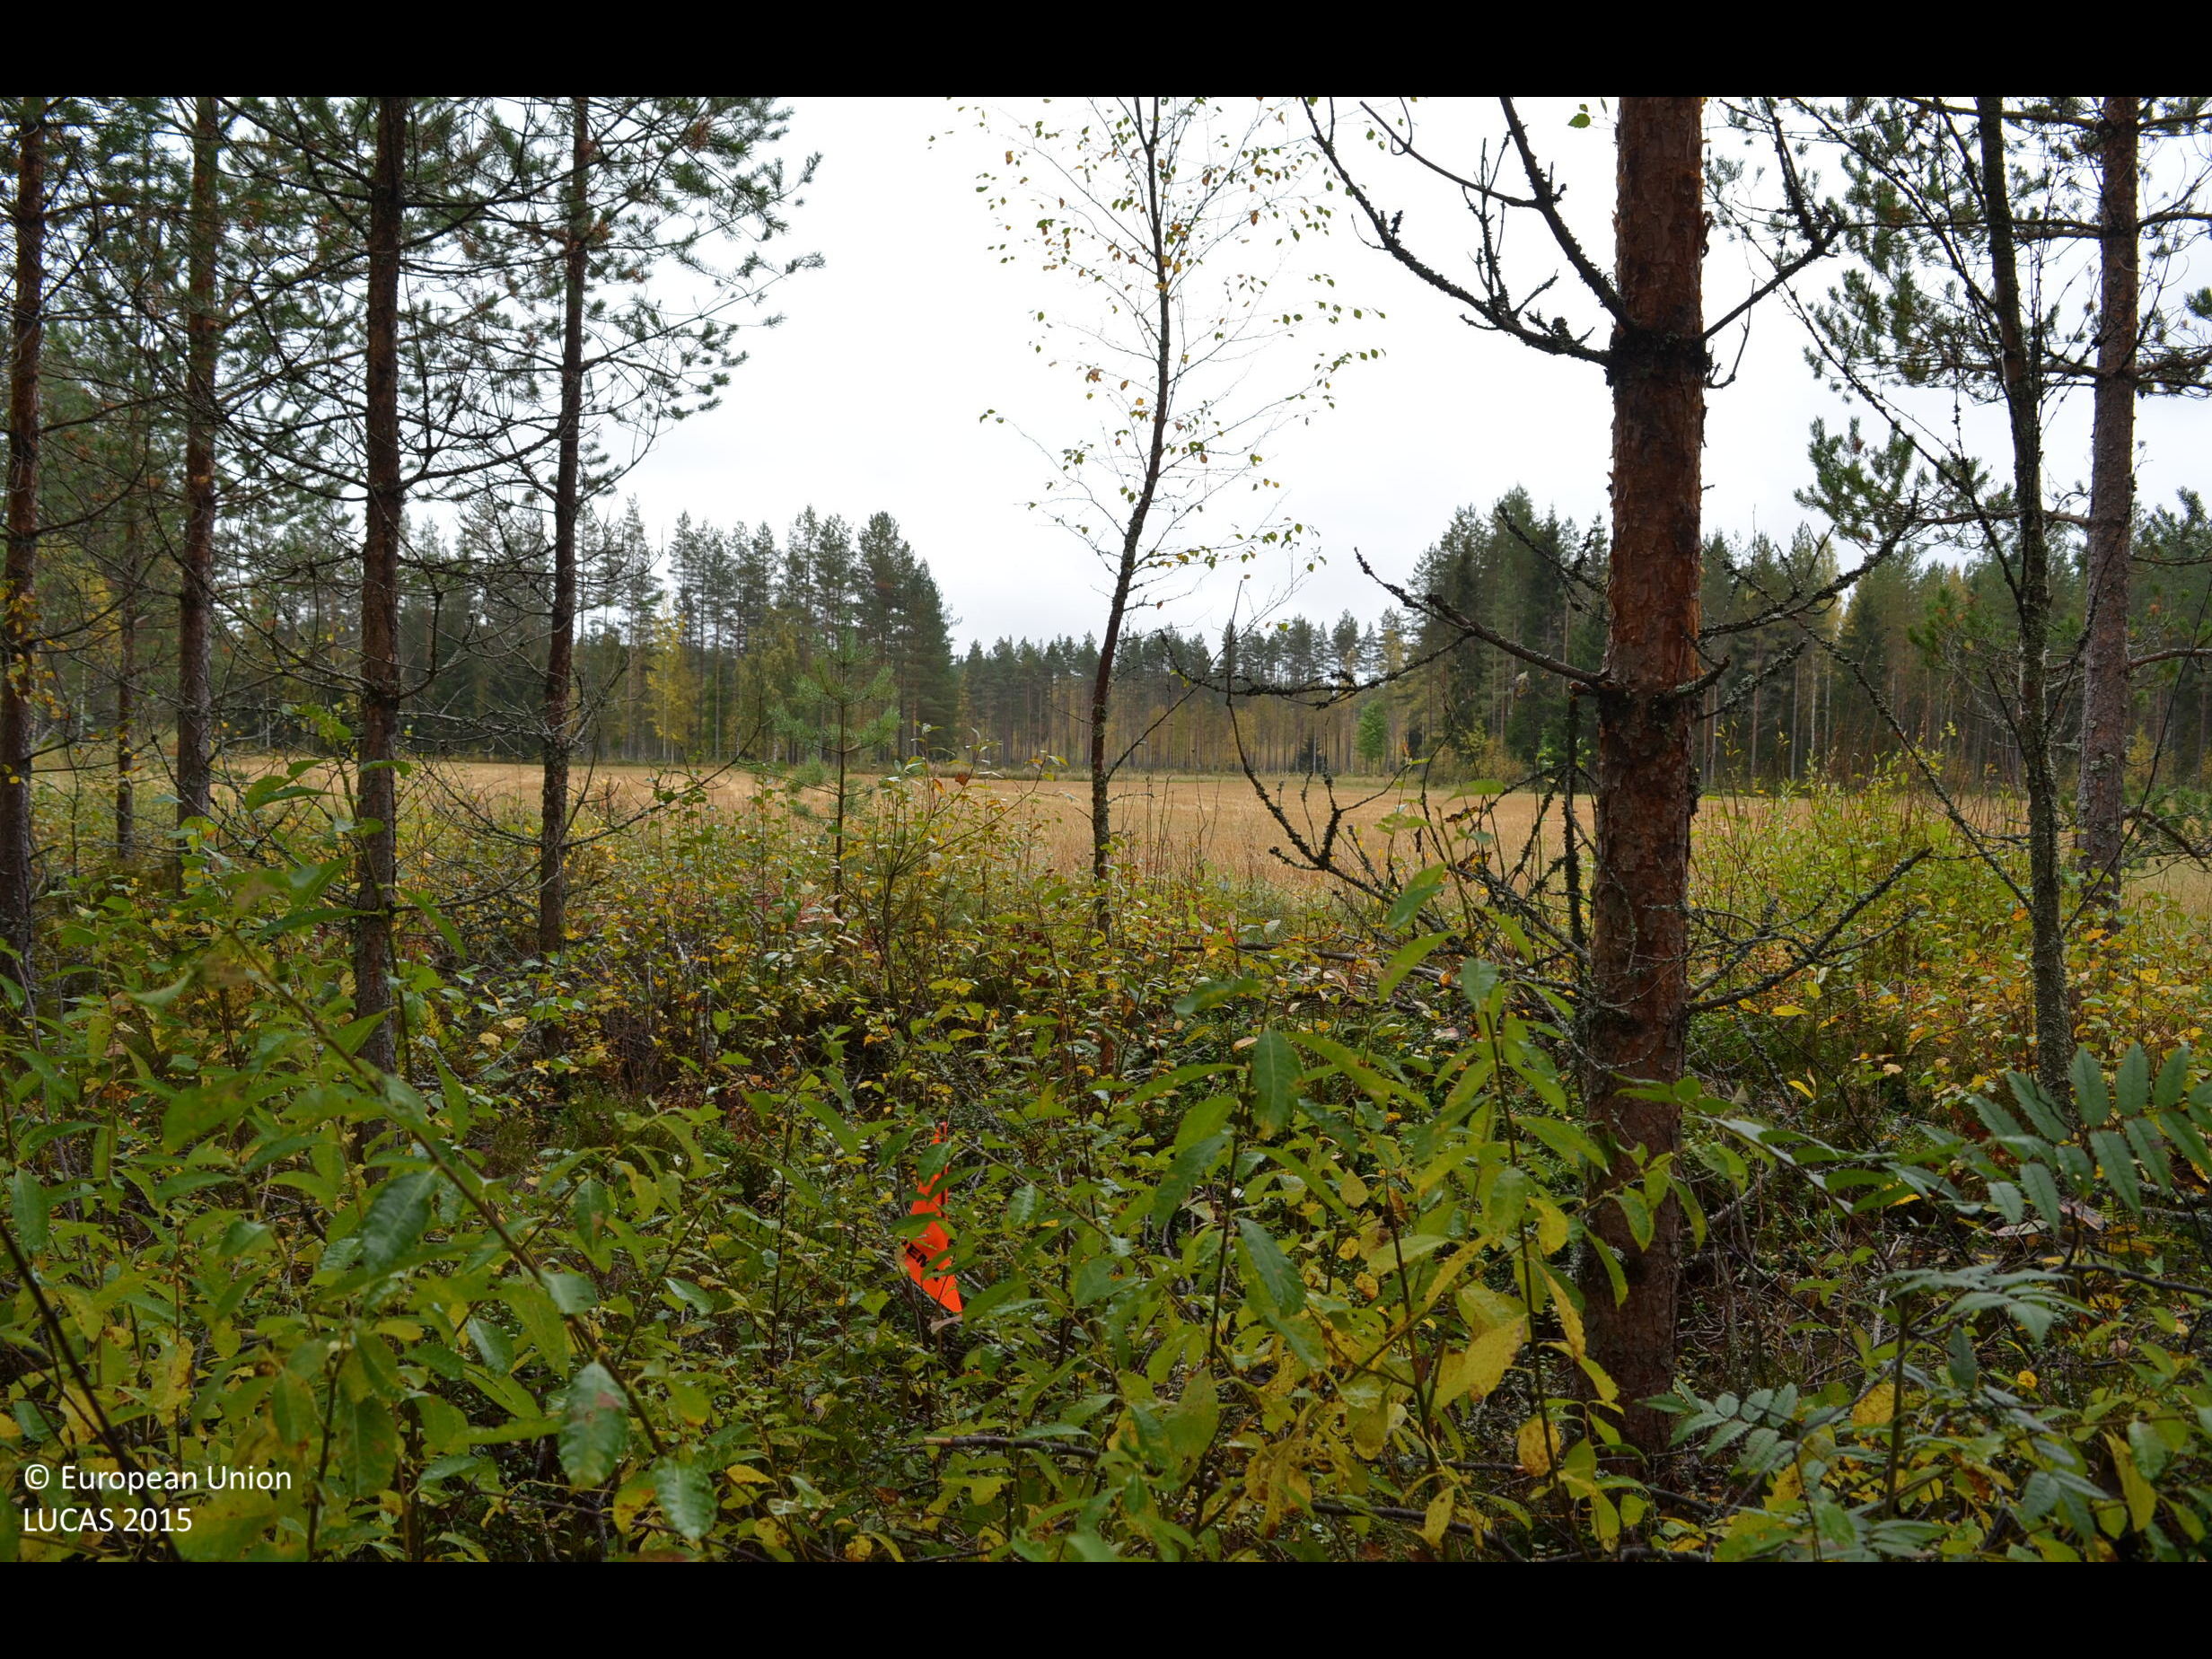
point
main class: Woodland
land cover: Pine dominated coniferous woodland
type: boreal forest
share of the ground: > 75 %
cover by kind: coniferous forest trees 75 %, shrubs 20 %, broadleaved forest trees 5 %
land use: Forestry
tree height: > 5 m
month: September
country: FI
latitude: 62.6564
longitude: 23.7539
